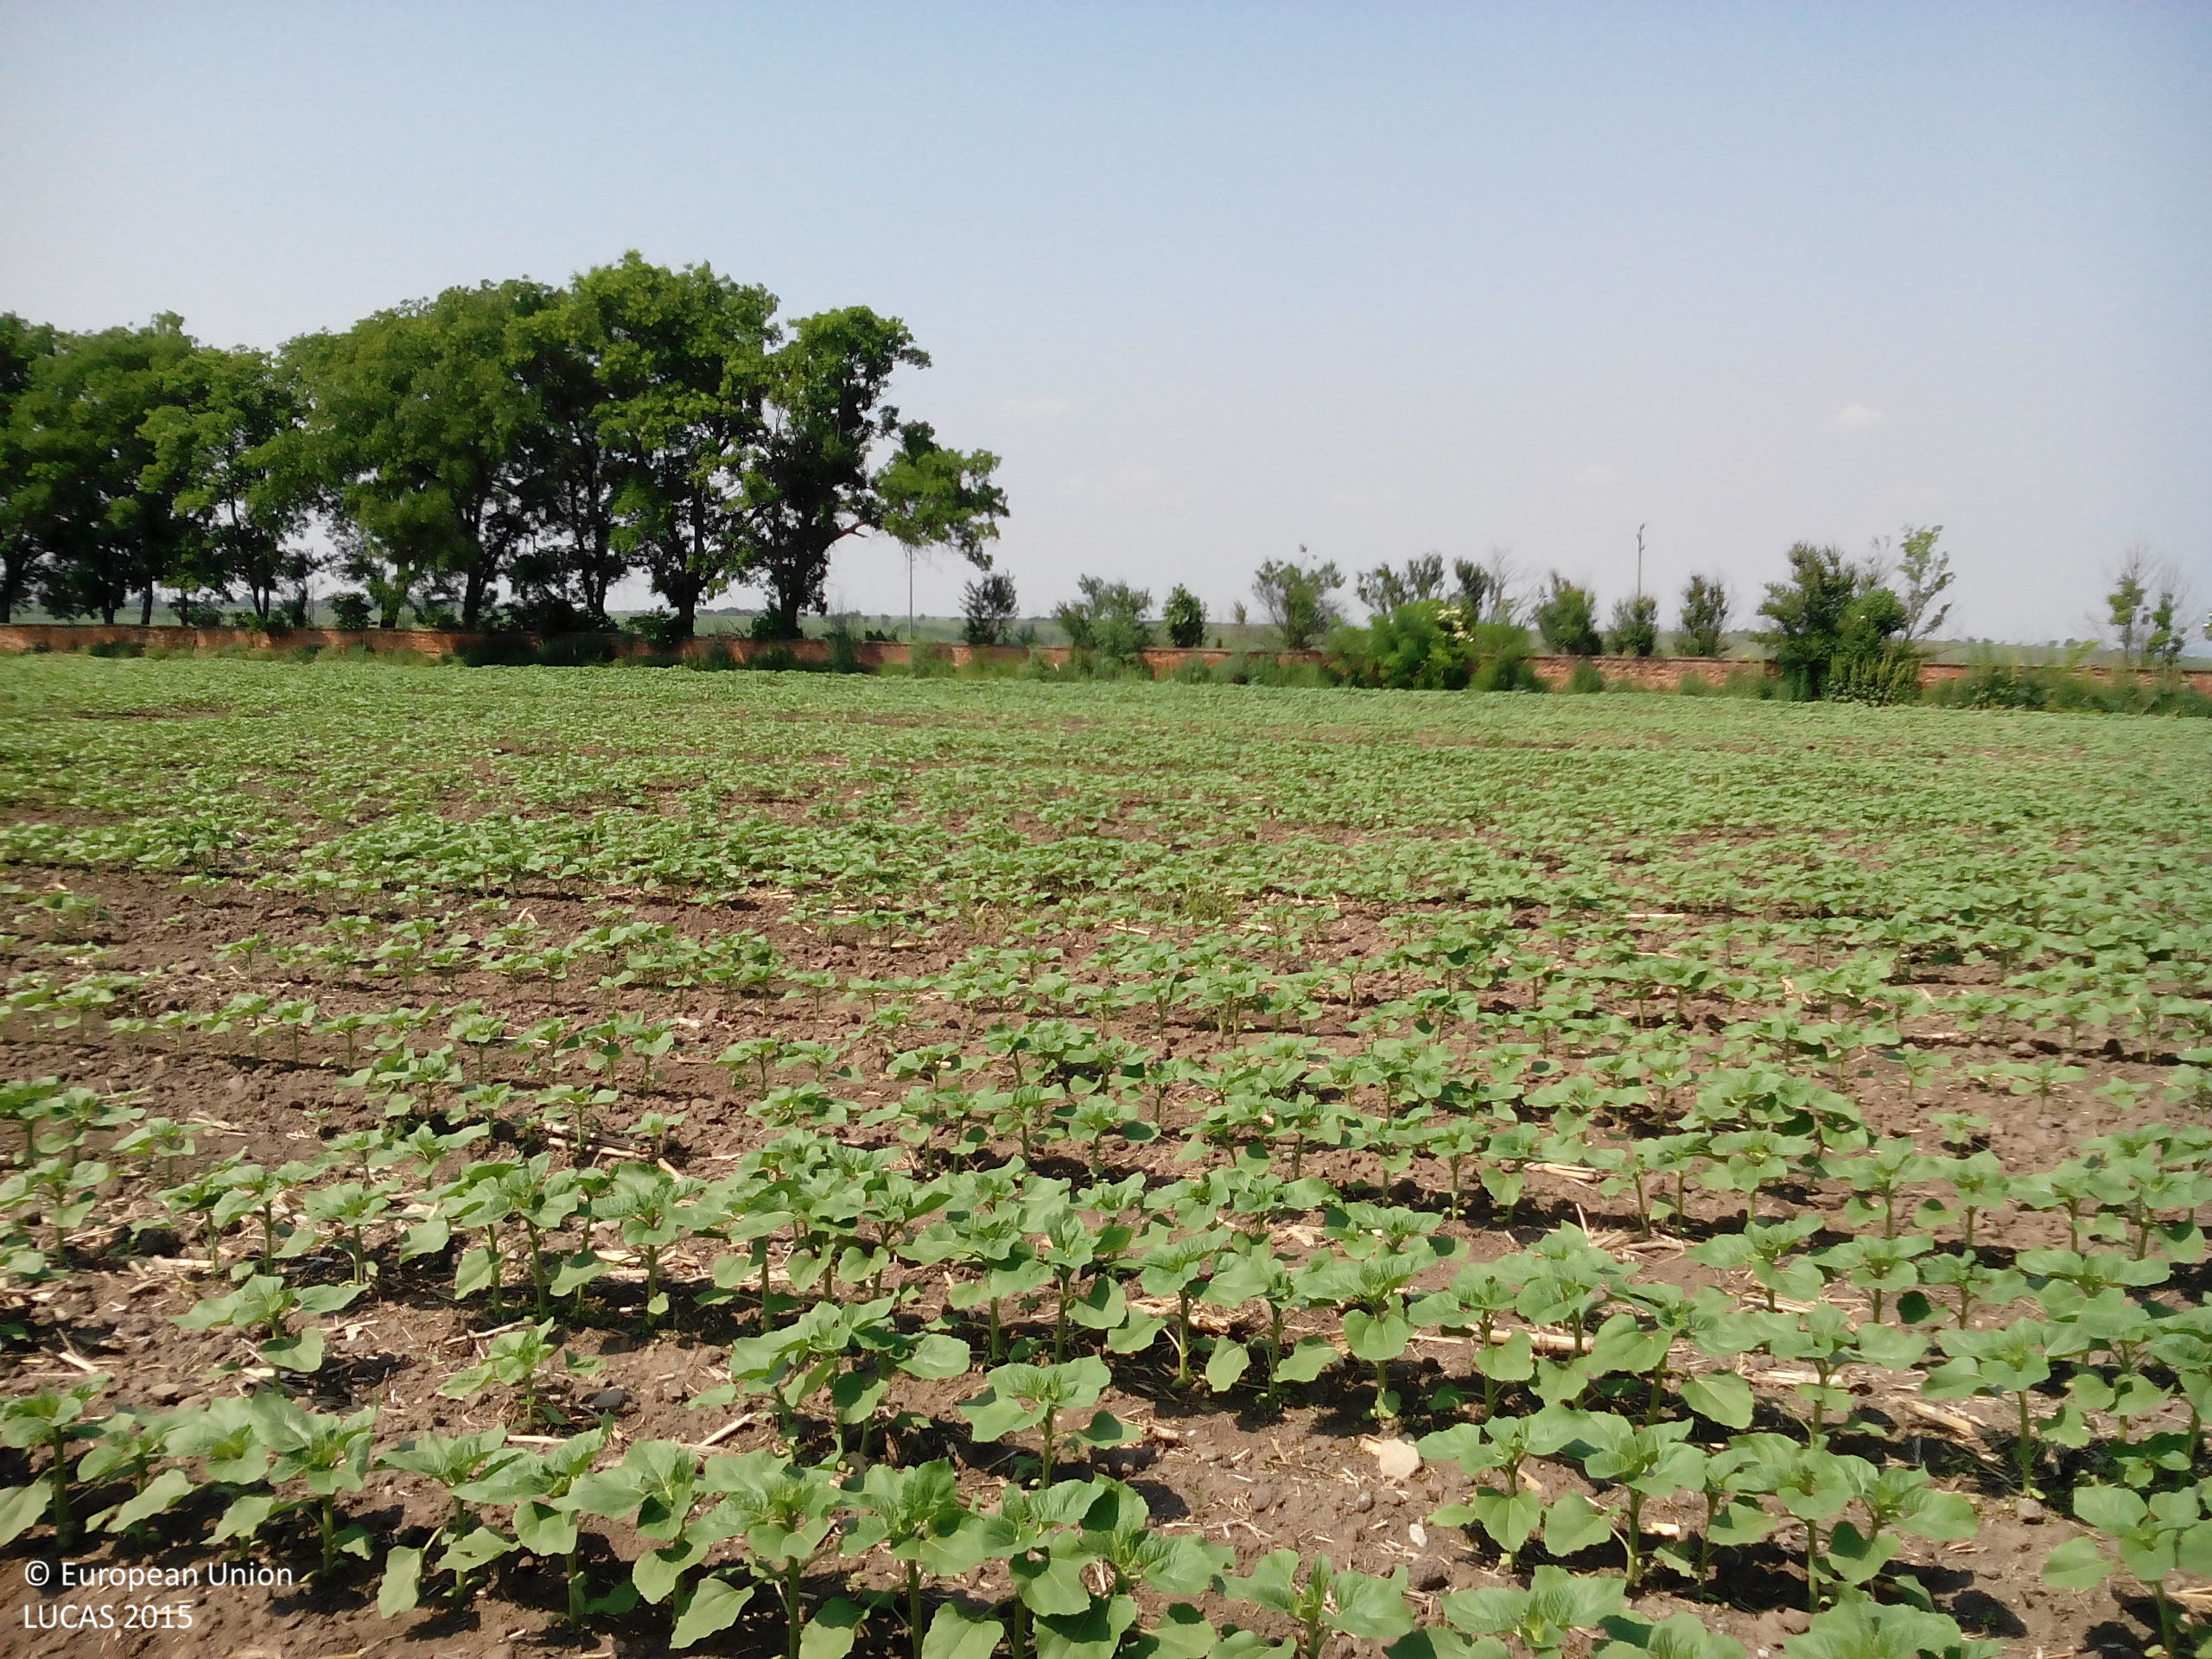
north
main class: Cropland
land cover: Sunflower
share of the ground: 25 - 50 %
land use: Agriculture (excluding fallow land and kitchen gardens)
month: May
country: BG
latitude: 43.6416
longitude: 24.0758
